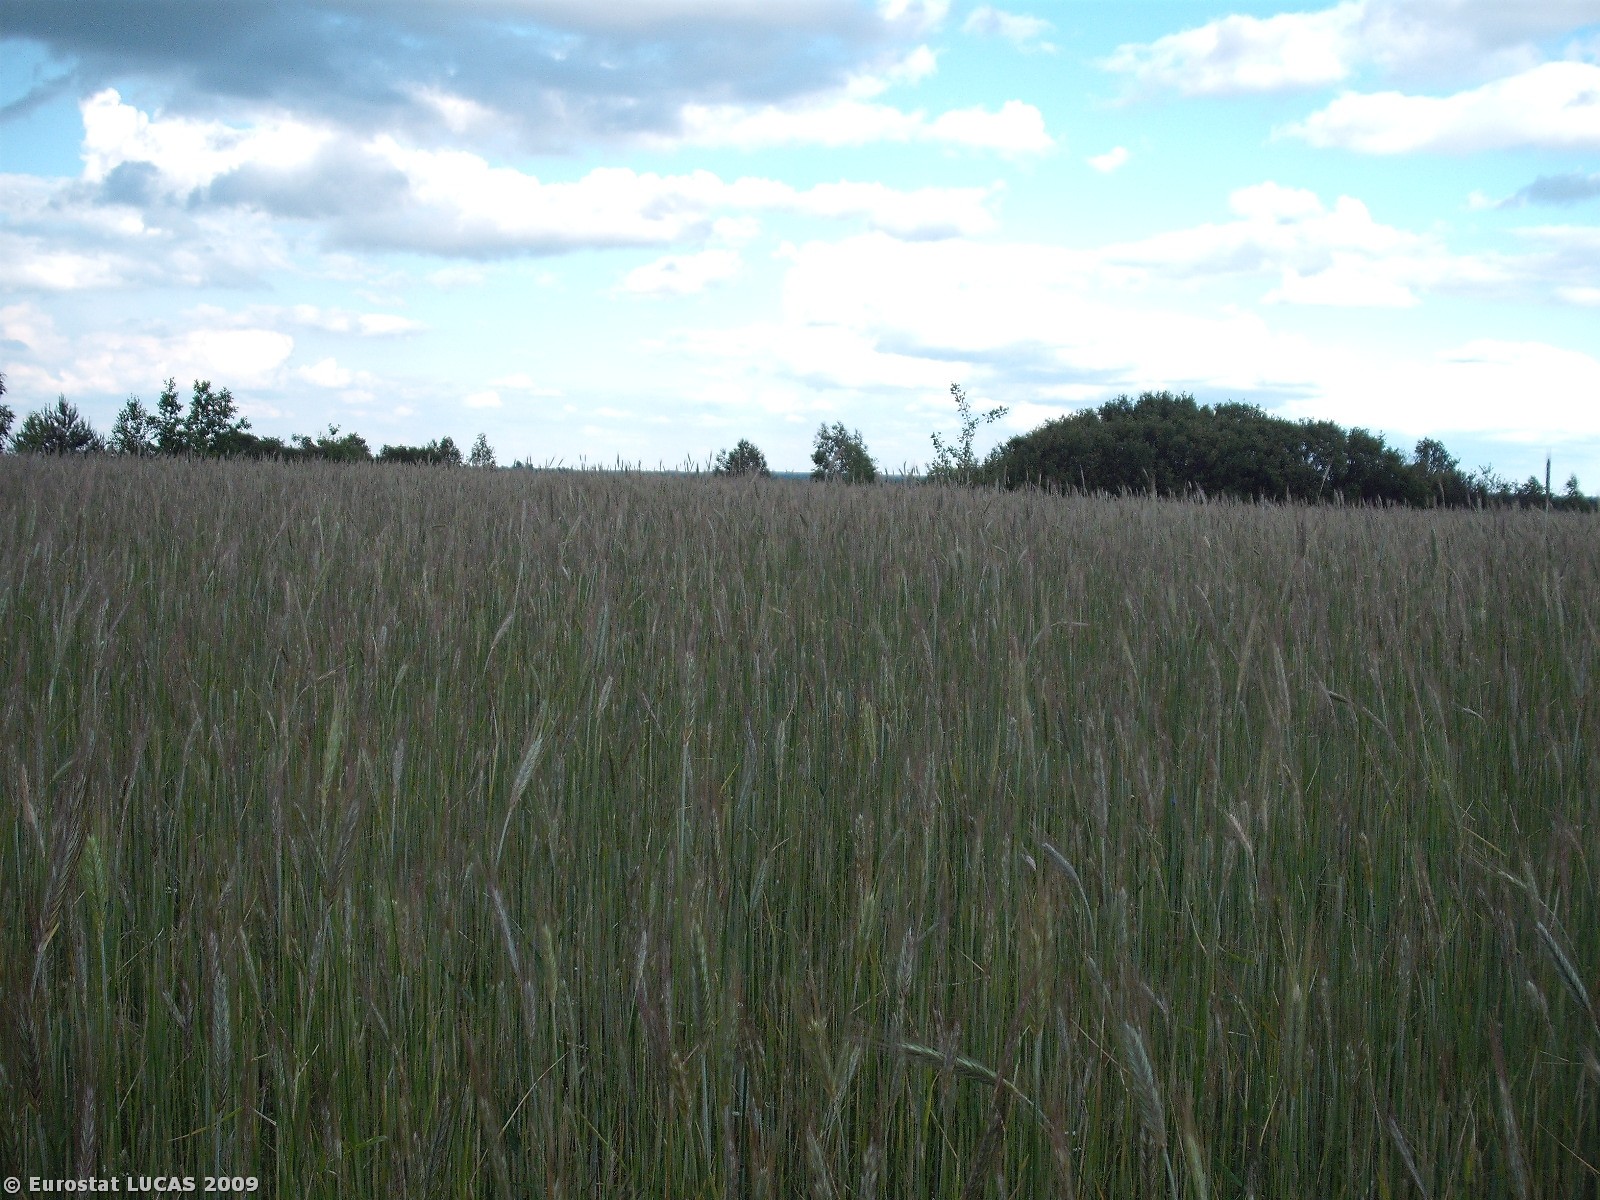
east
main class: Cropland
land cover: Rye
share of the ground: > 75 %
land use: Agriculture (excluding fallow land and kitchen gardens)
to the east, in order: Rye; Grassland with sparse tree/shrub cover; Oats; Rye; Grassland with sparse tree/shrub cover; Rye; Grass margins; Triticale; Grass margins; Oats
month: June
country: PL
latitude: 51.3137
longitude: 20.8748
